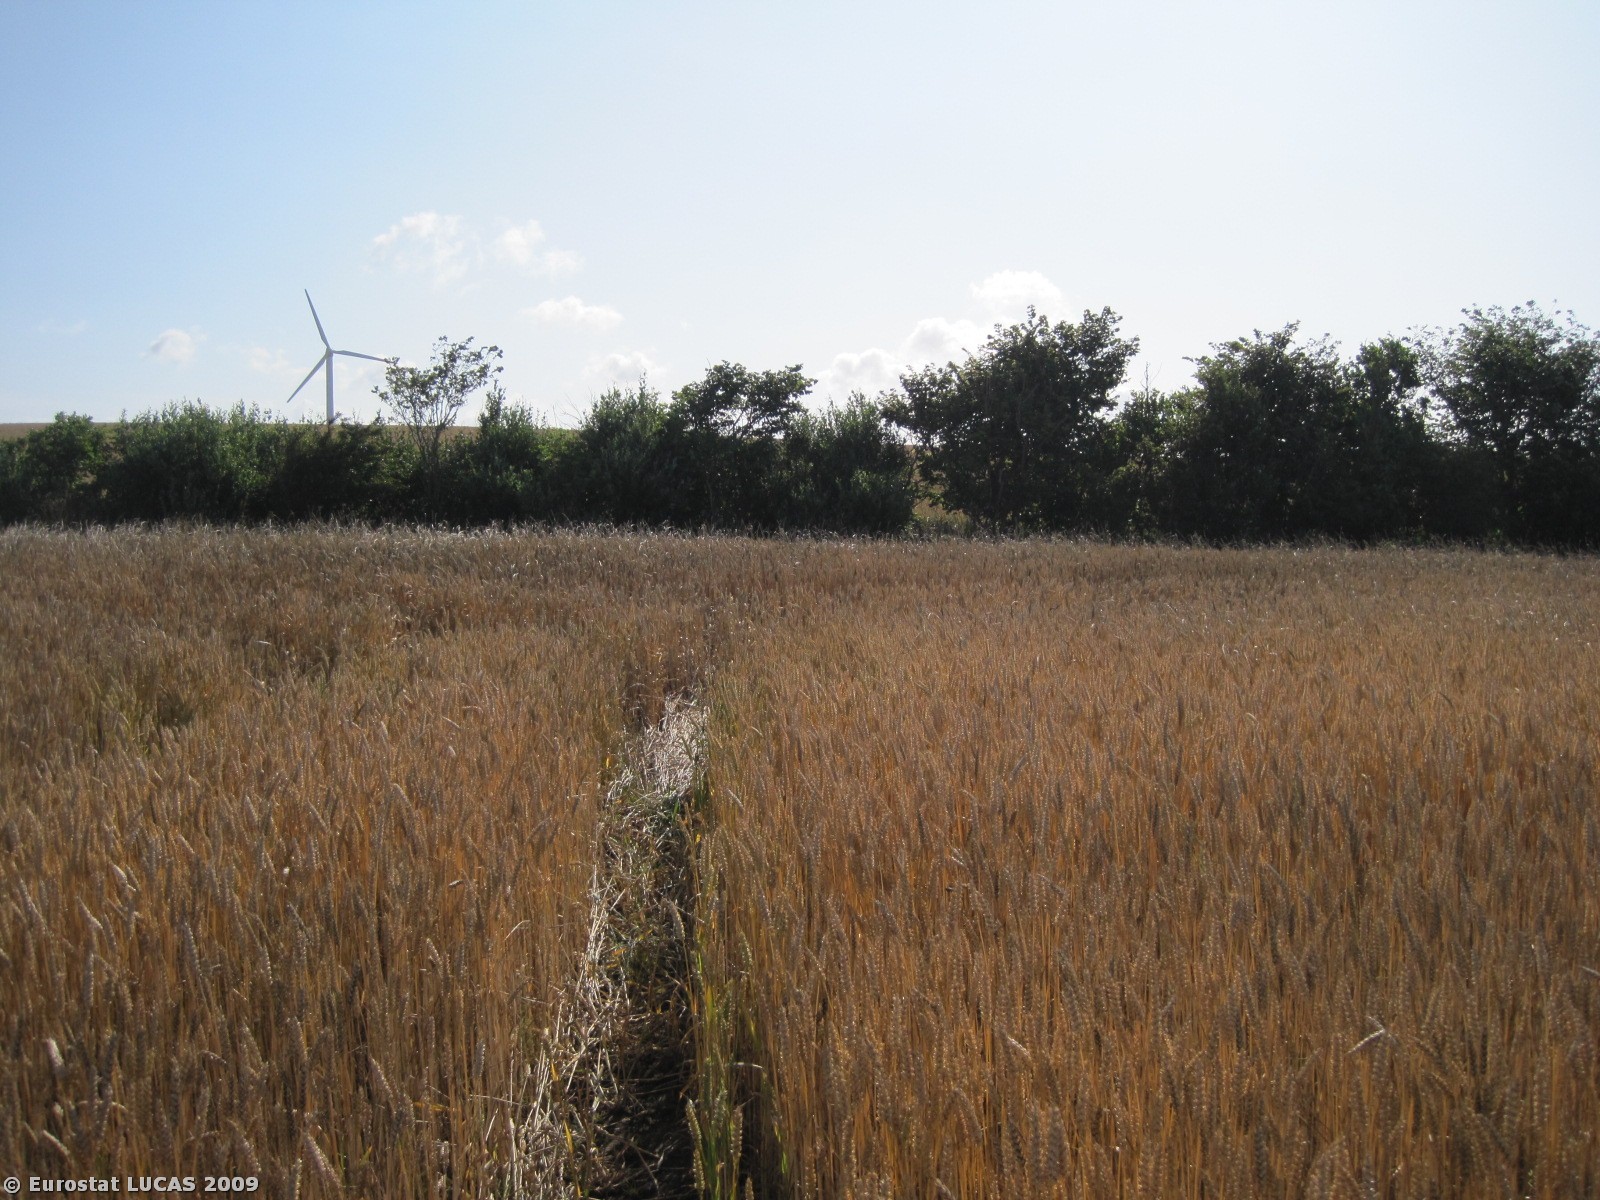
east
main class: Cropland
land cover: Common wheat
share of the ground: > 75 %
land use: Agriculture (excluding fallow land and kitchen gardens)
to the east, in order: Common wheat; Grass margins; Broadleaved woodland; Grass margins; Common wheat
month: July
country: DK
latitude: 56.7341
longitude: 8.3185
